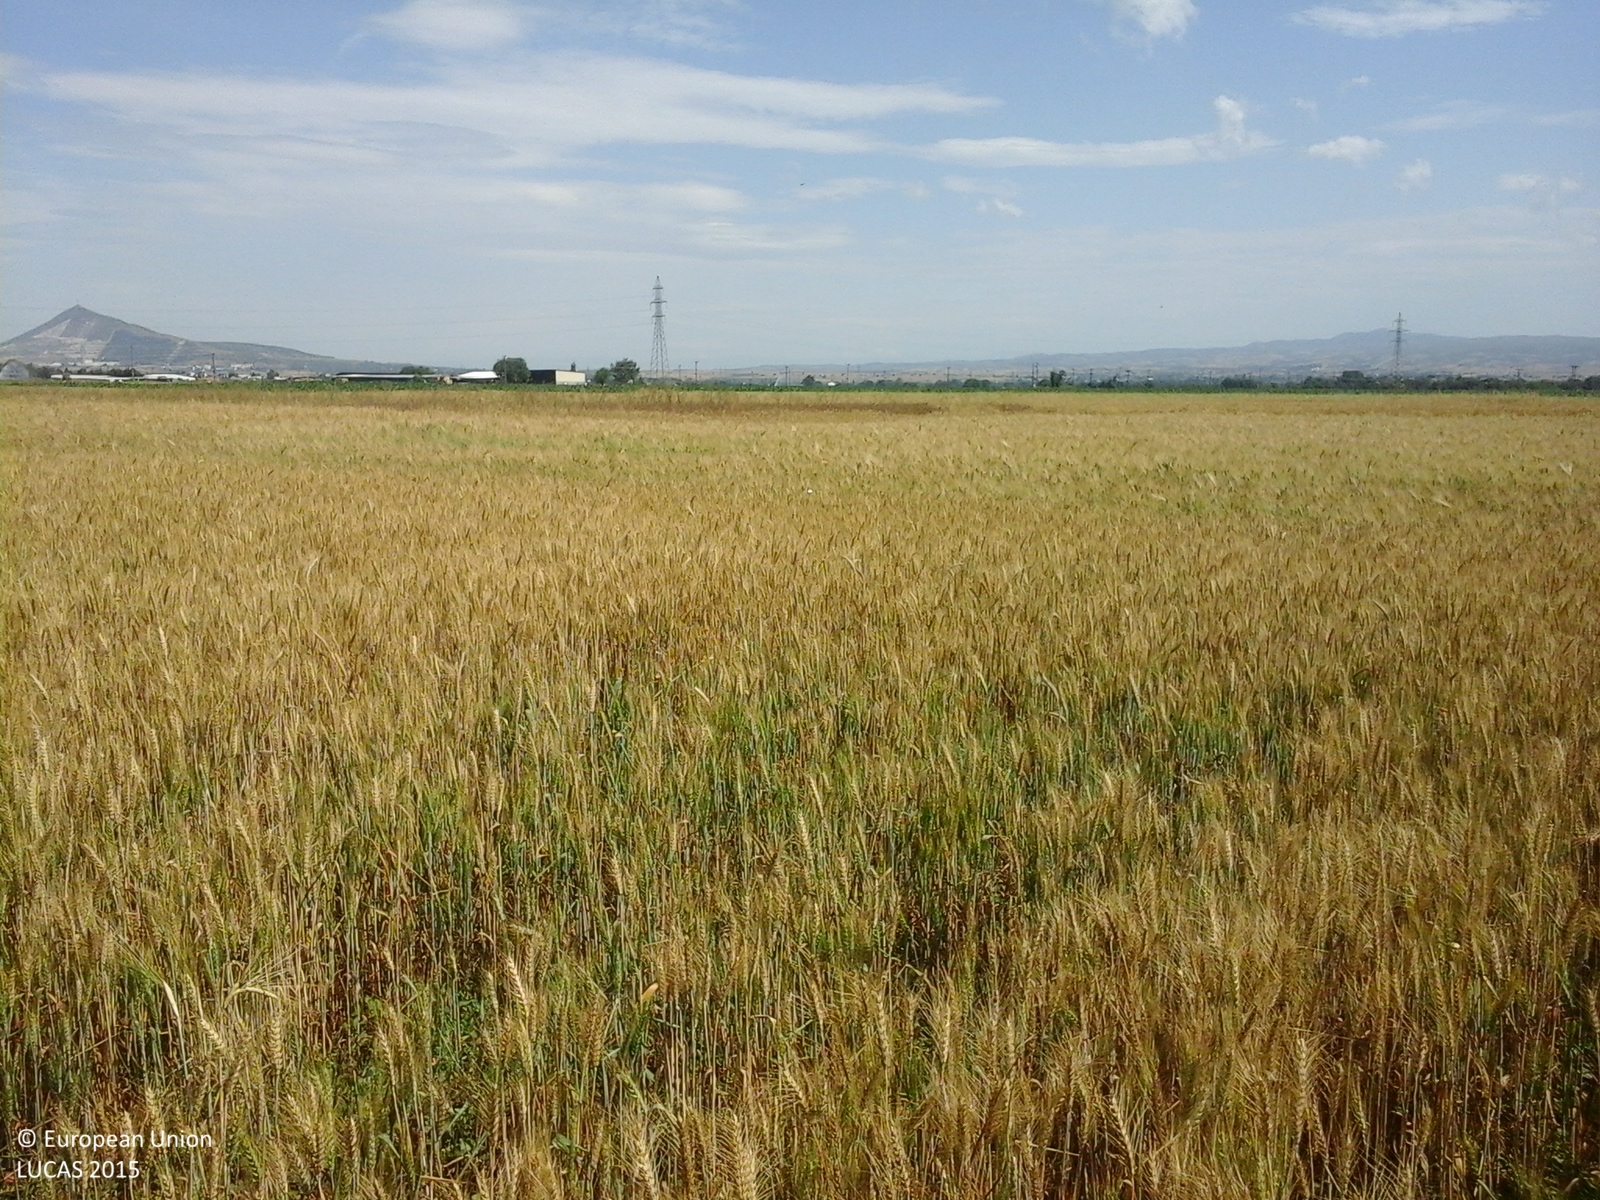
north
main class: Cropland
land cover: Common wheat
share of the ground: > 75 %
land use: Agriculture (excluding fallow land and kitchen gardens)
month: June
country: GR
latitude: 40.7519
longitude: 23.0023
